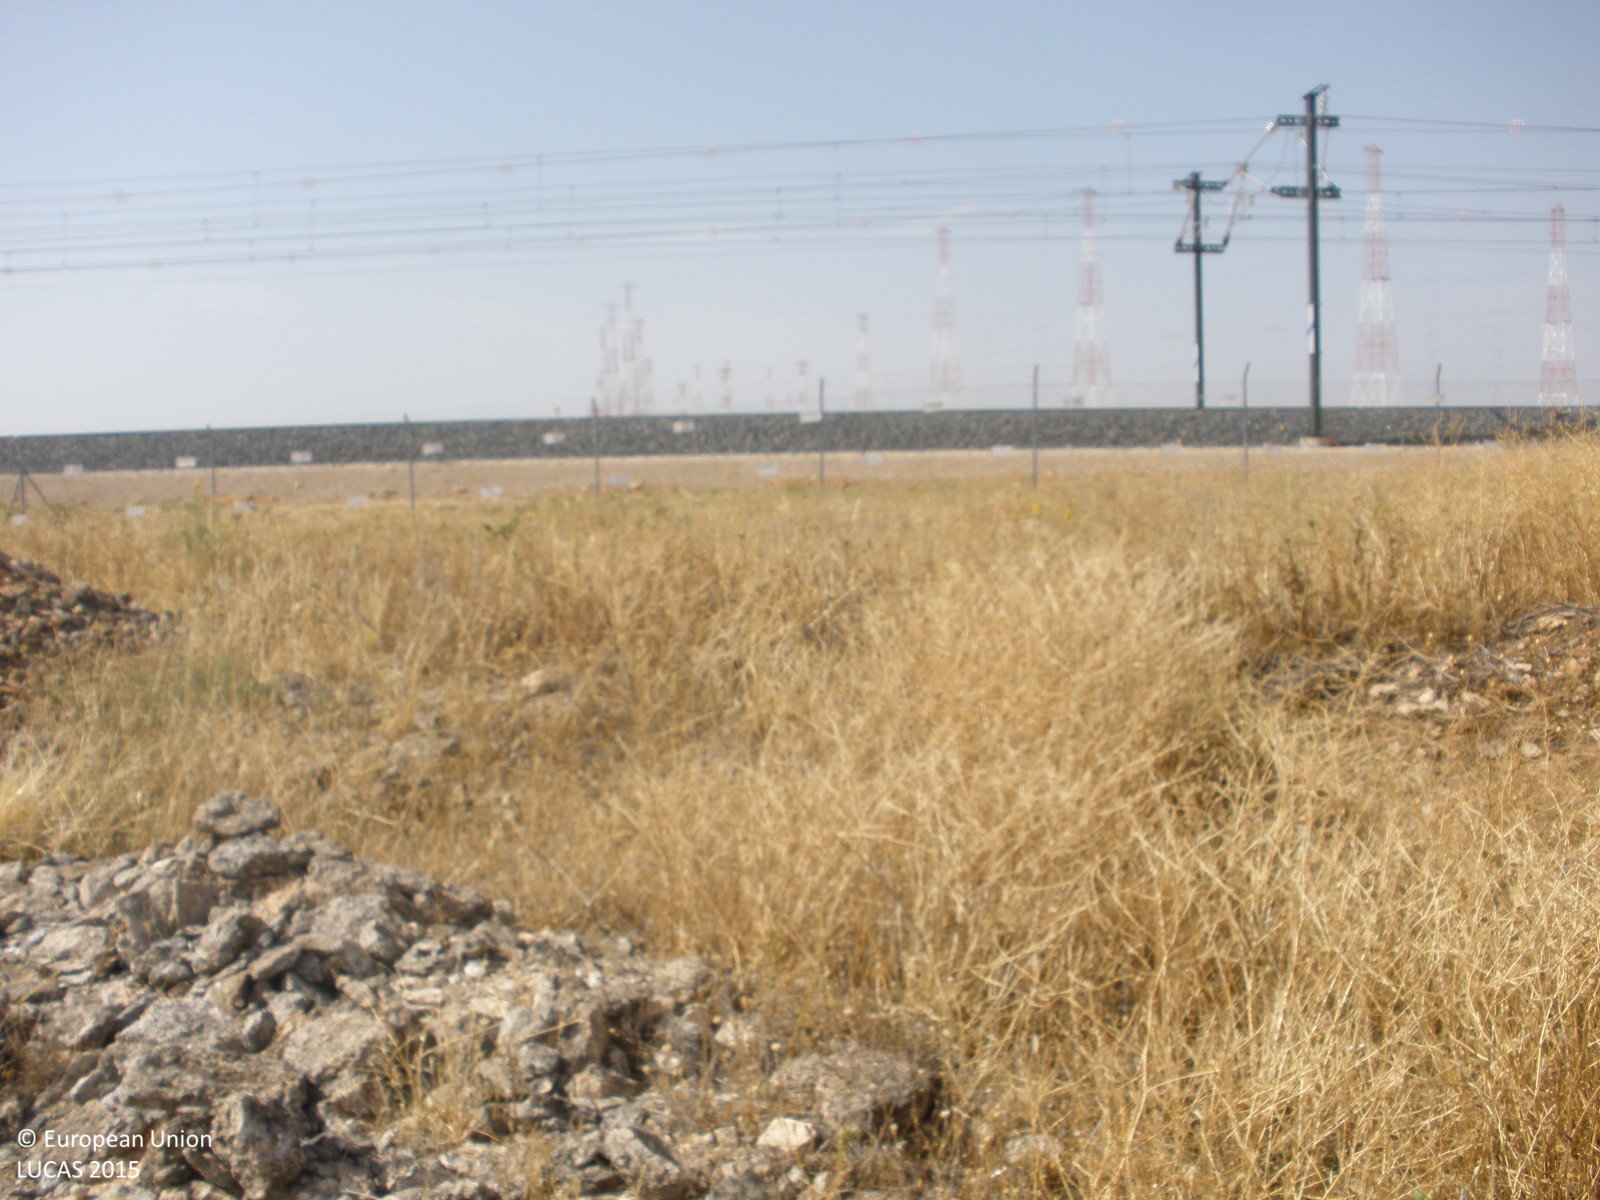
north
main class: Grassland
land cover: Grassland without tree/shrub cover
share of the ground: > 75 %
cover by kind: herbaceous plants 75 %, consolidated bare surface 25 %
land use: Abandoned areas
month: July
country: ES
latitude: 39.9439
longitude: -3.4286
